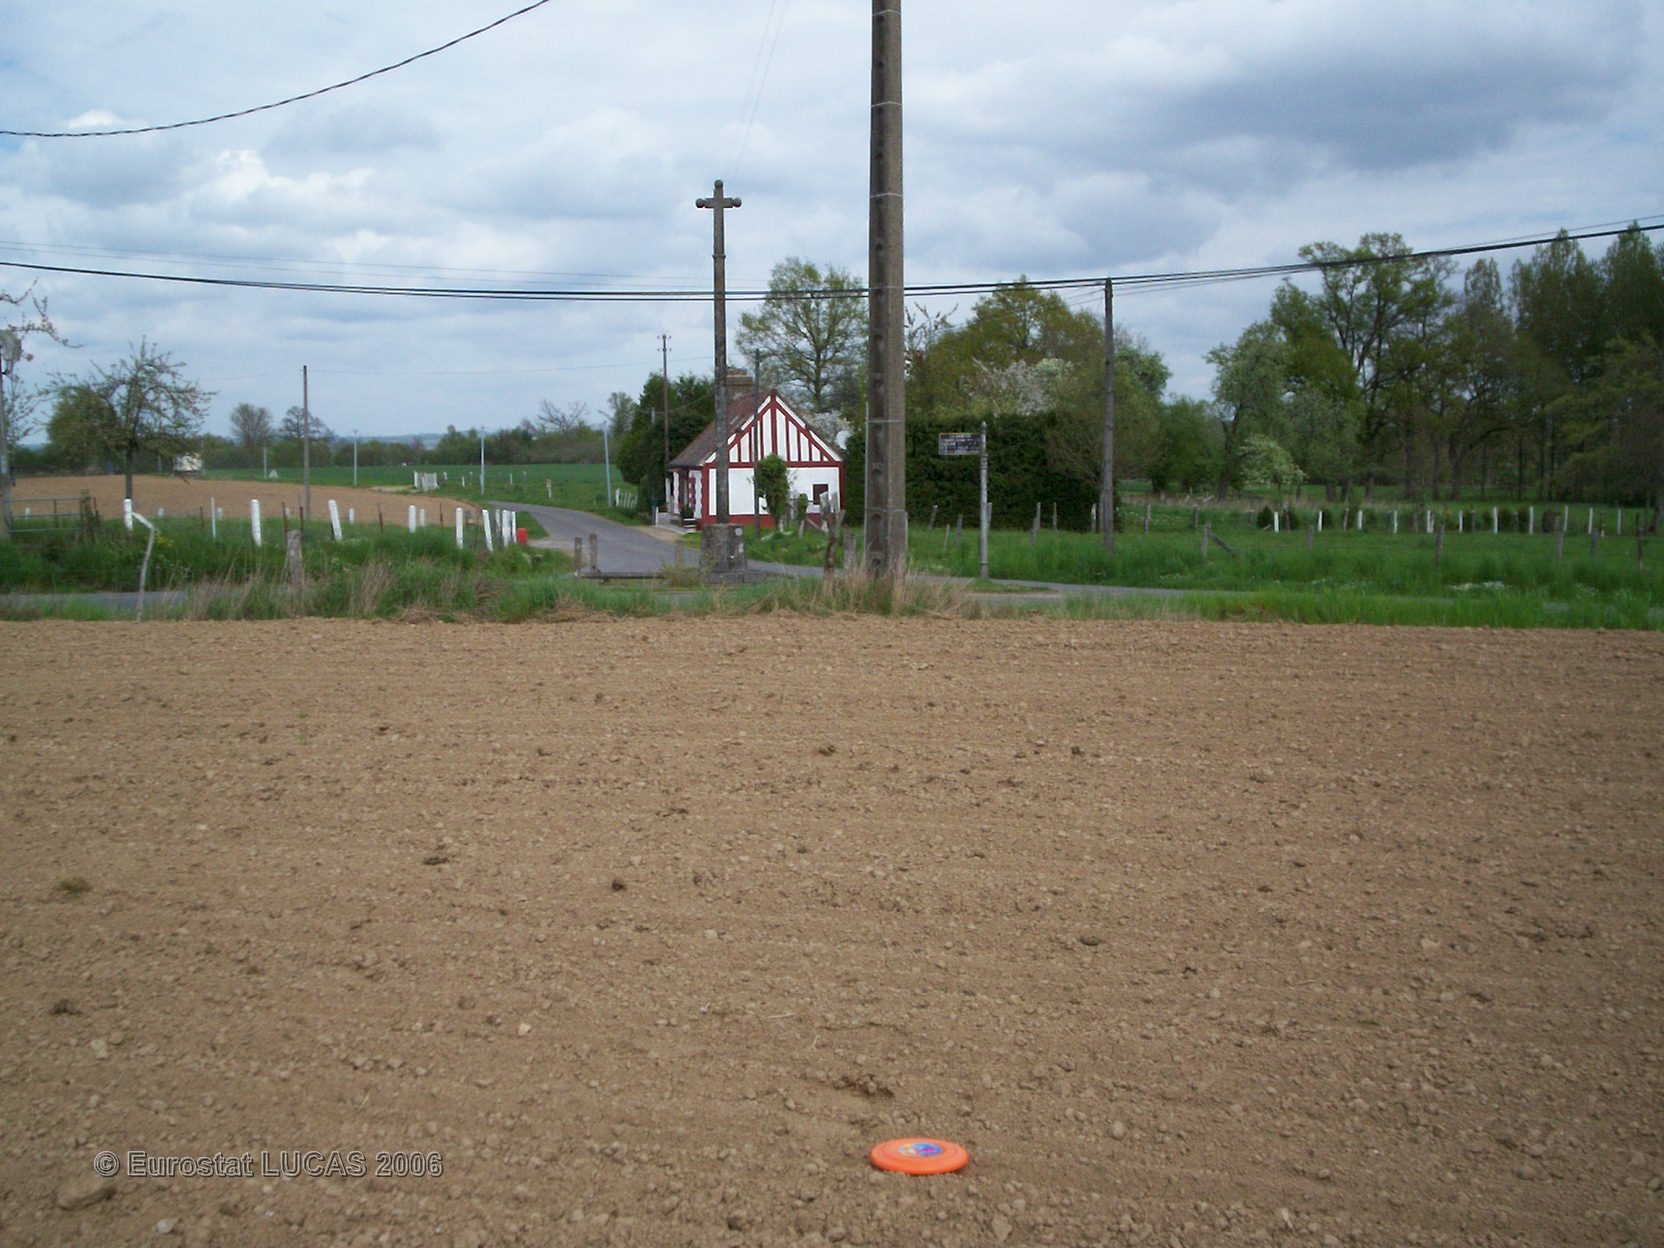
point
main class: Cropland
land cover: Maize
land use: Agriculture (excluding fallow land and kitchen gardens)
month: May
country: FR
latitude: 48.5694
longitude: -0.7303
